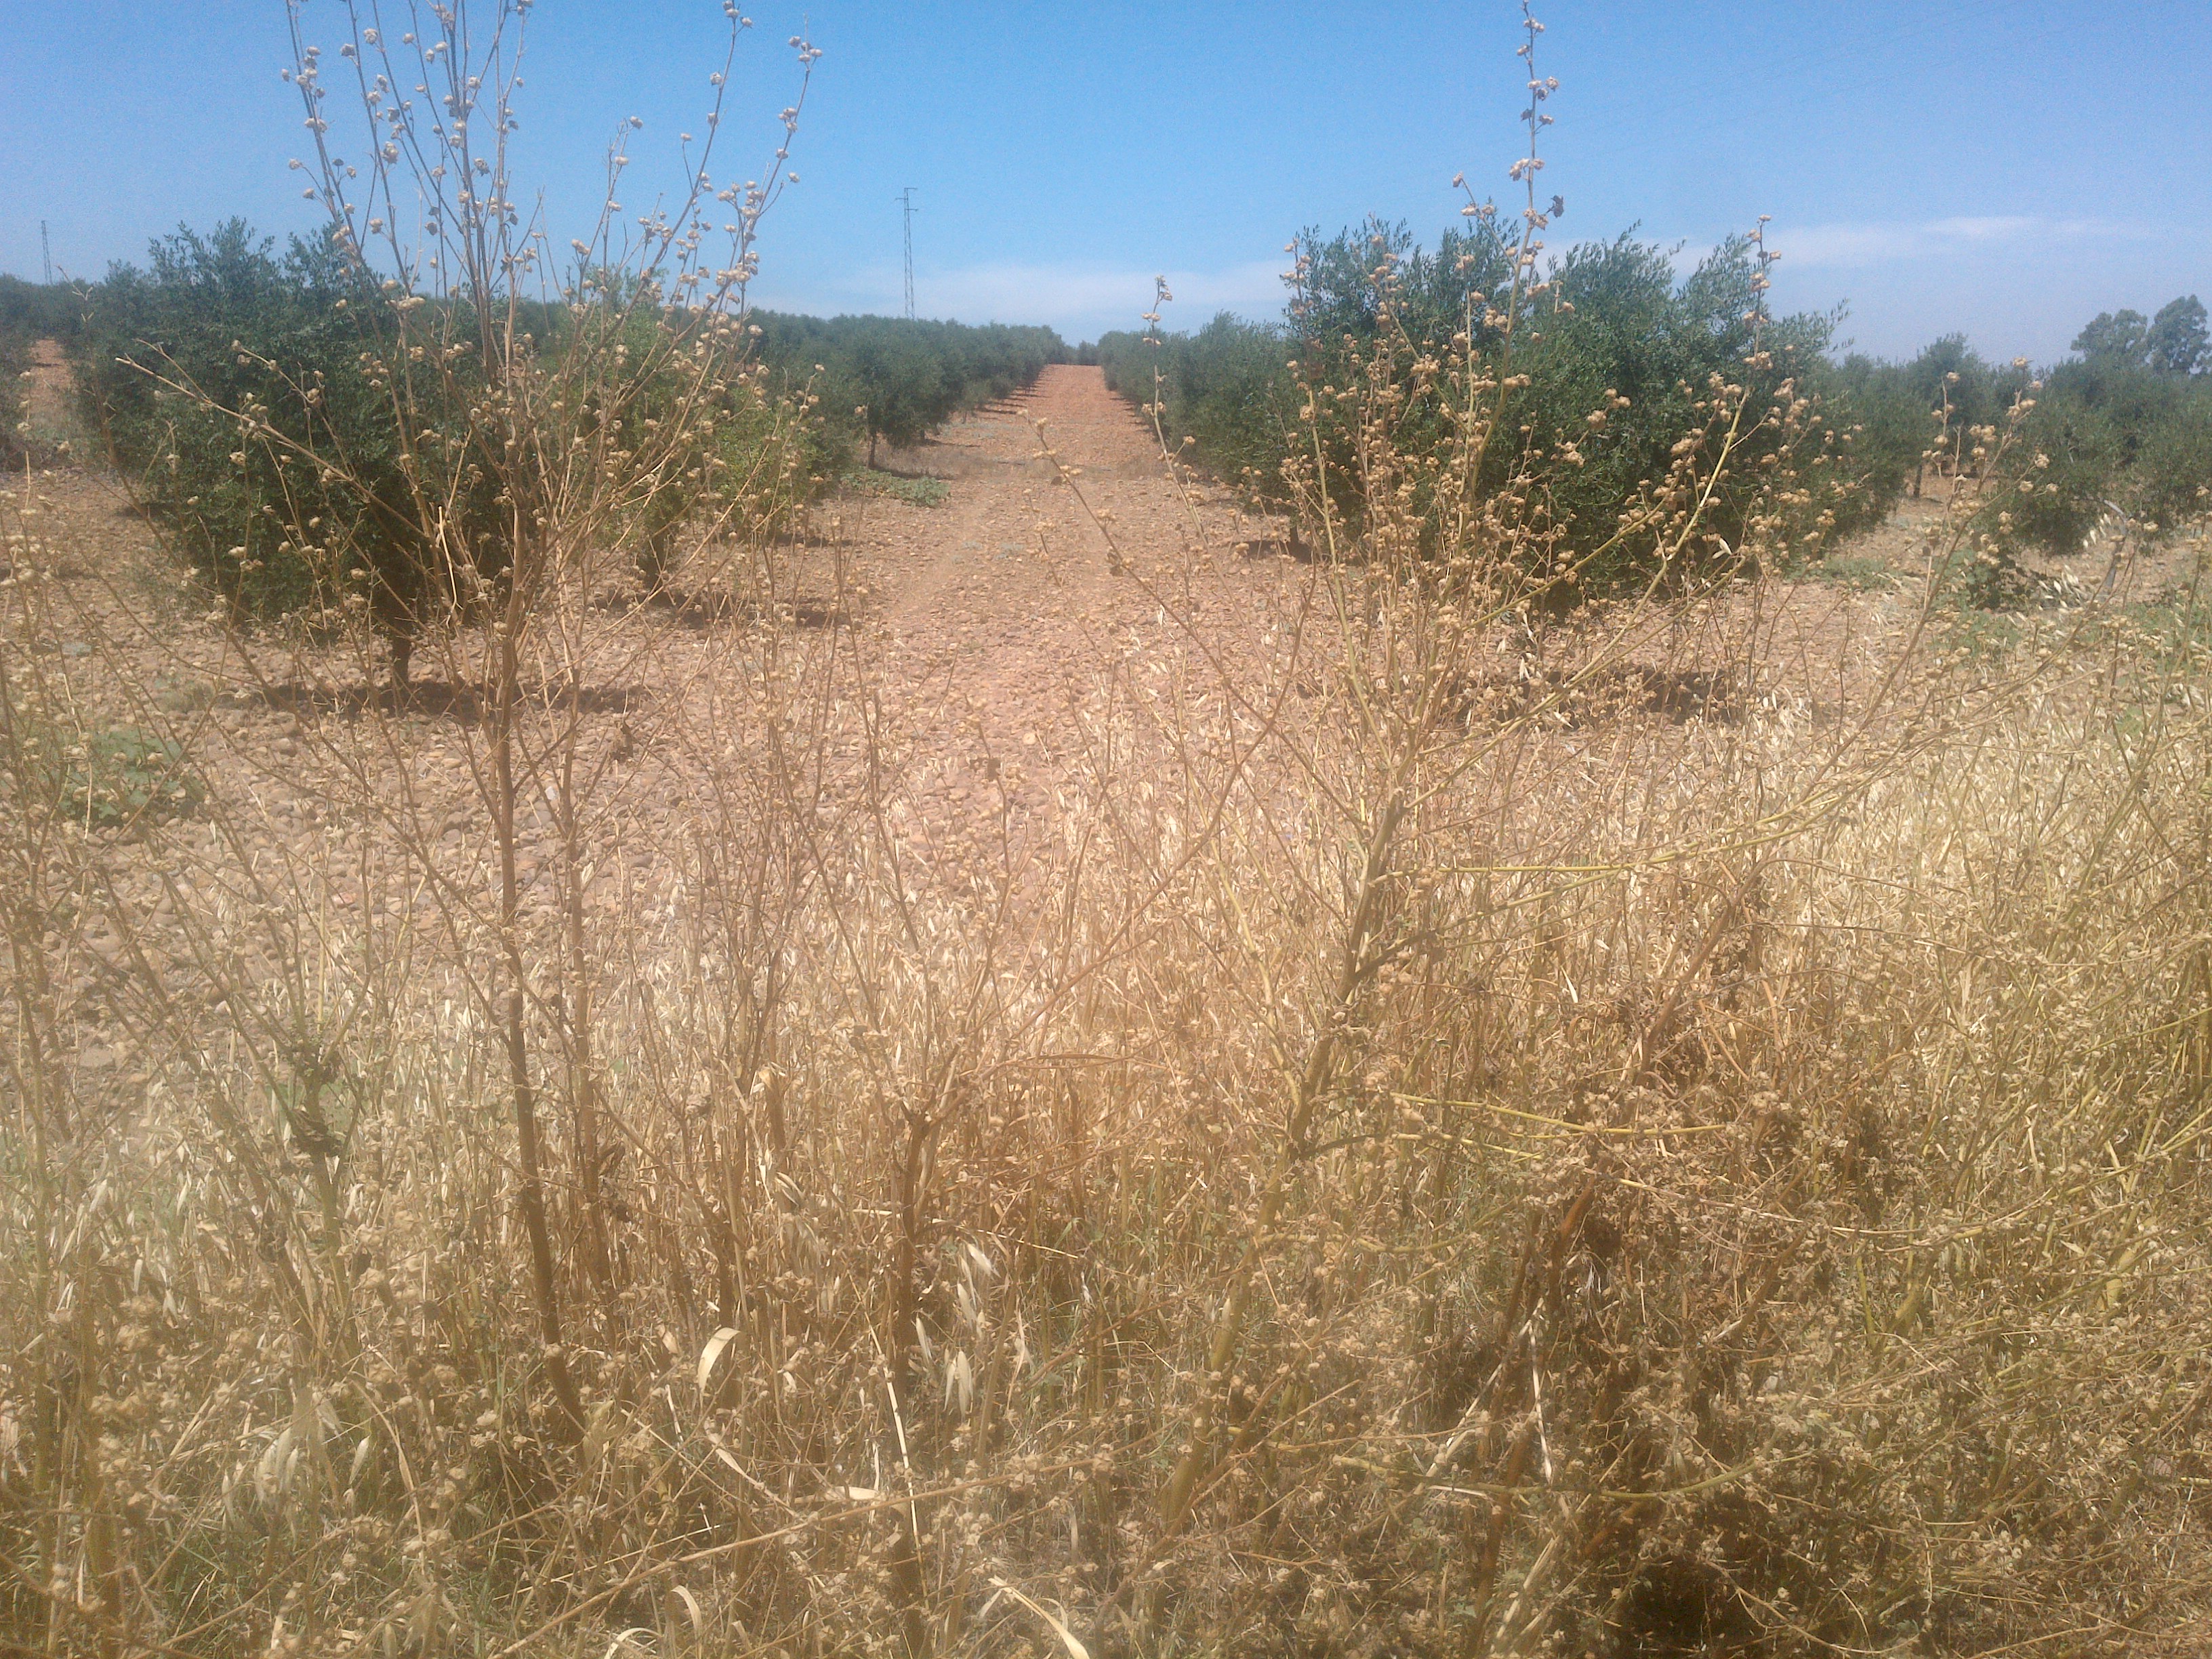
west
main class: Cropland
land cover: Sunflower
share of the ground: > 75 %
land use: Agriculture (excluding fallow land and kitchen gardens)
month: June
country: ES
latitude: 37.6387
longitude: -4.8684
